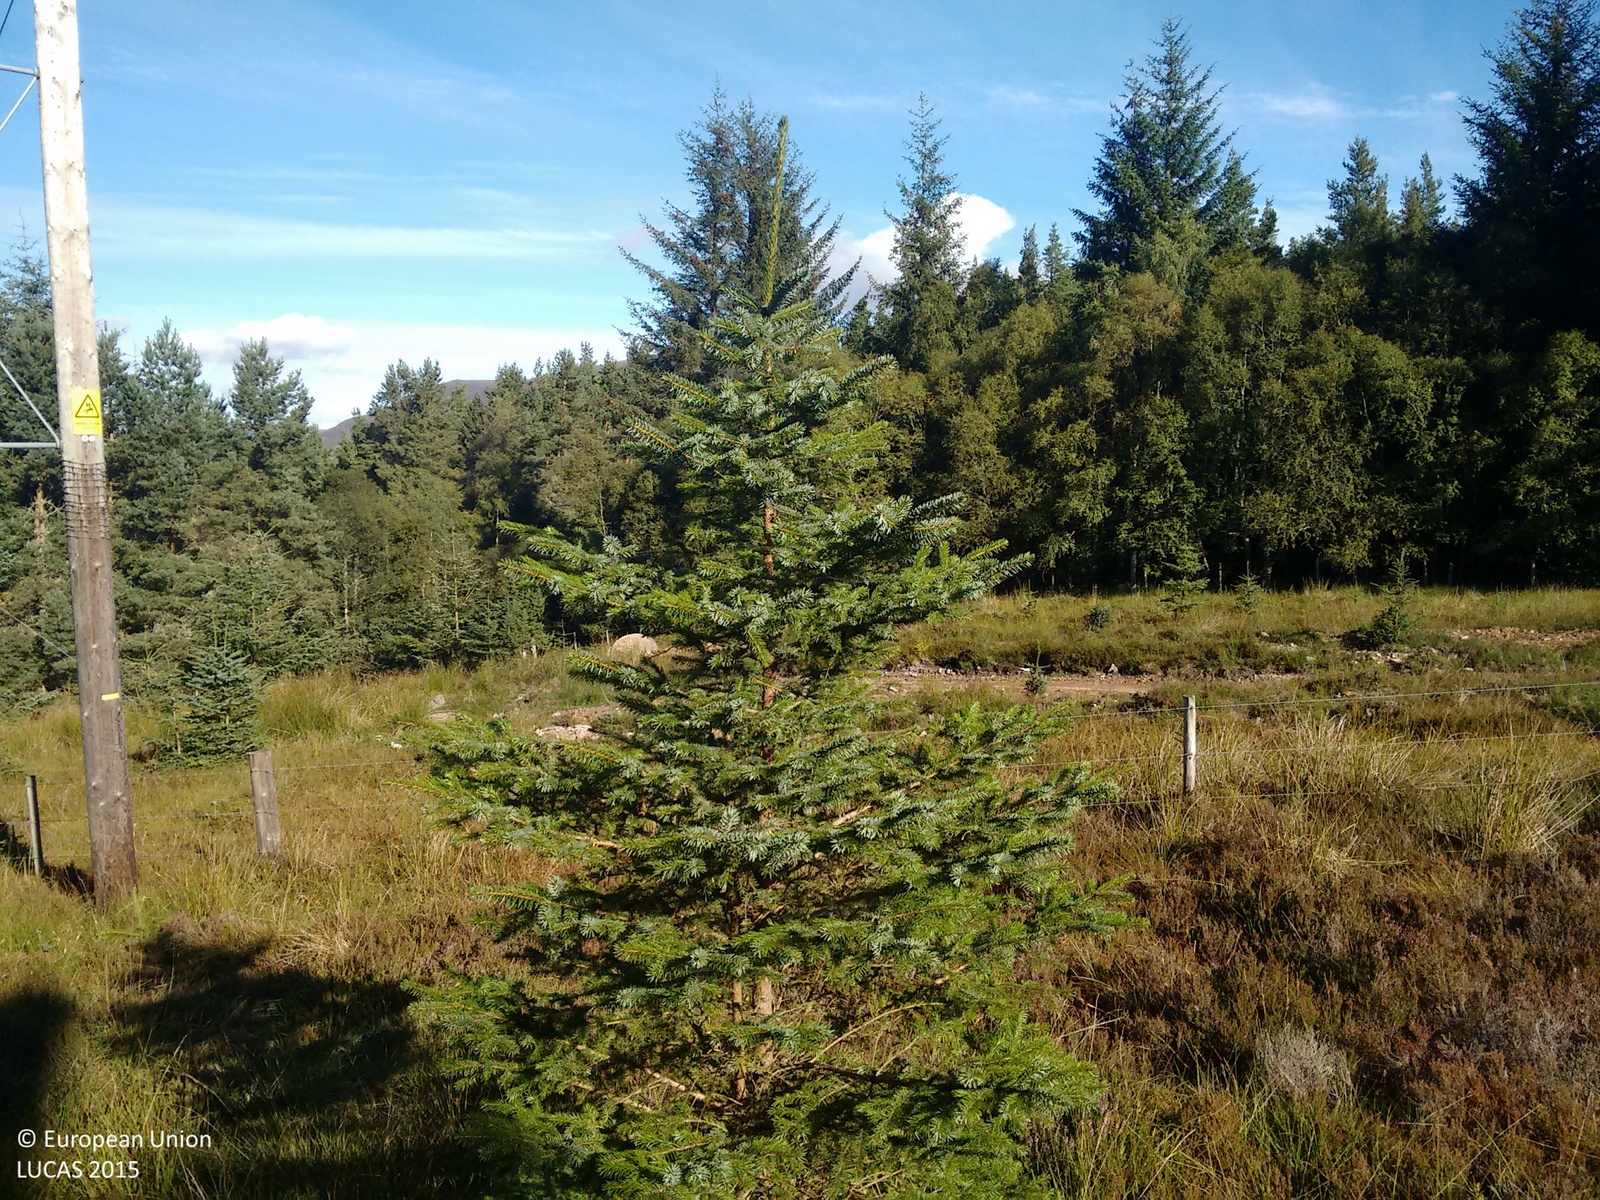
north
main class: Shrubland
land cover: Shrubland with sparse tree cover
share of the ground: > 75 %
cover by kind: shrubs 70 %, lichens and mosses 15 %, herbaceous plants 10 %, coniferous forest trees 5 %
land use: Forestry
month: September
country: GB
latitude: 57.7196
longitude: -4.3394
